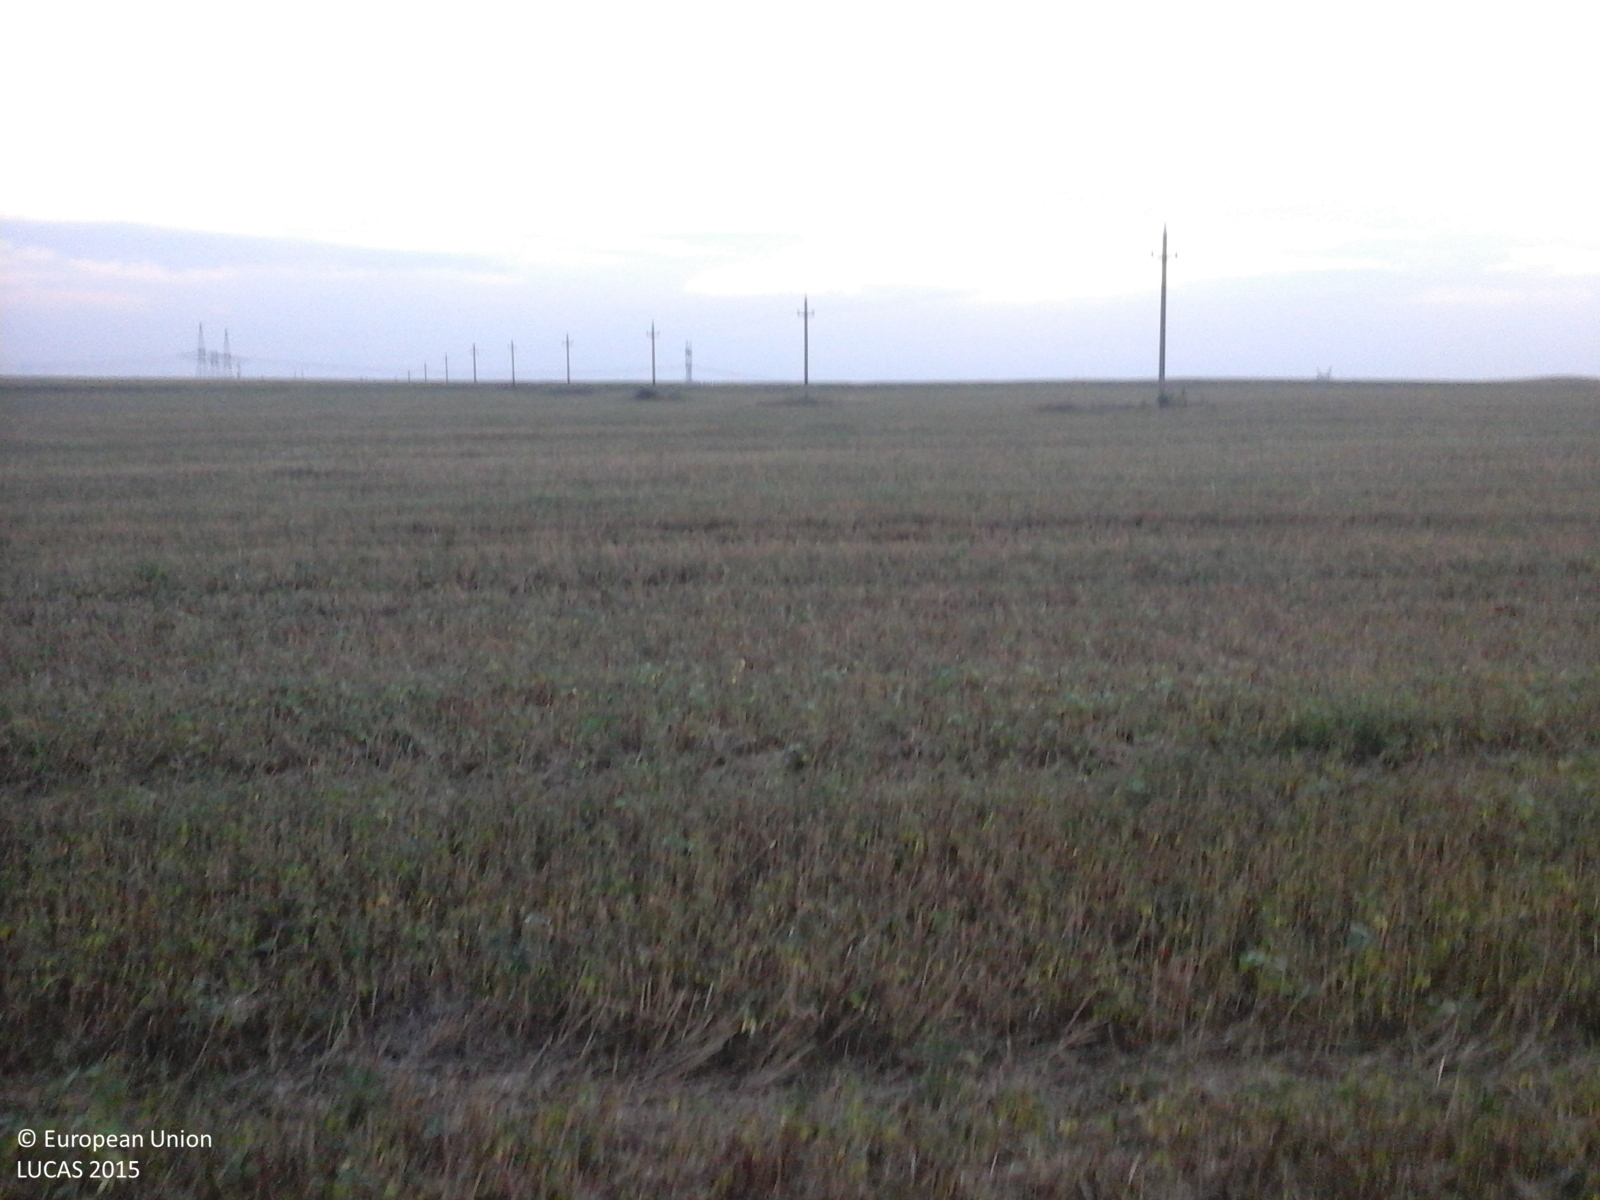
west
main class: Cropland
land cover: Maize
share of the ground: > 75 %
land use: Agriculture (excluding fallow land and kitchen gardens)
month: August
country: RO
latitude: 44.2325
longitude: 28.1245
